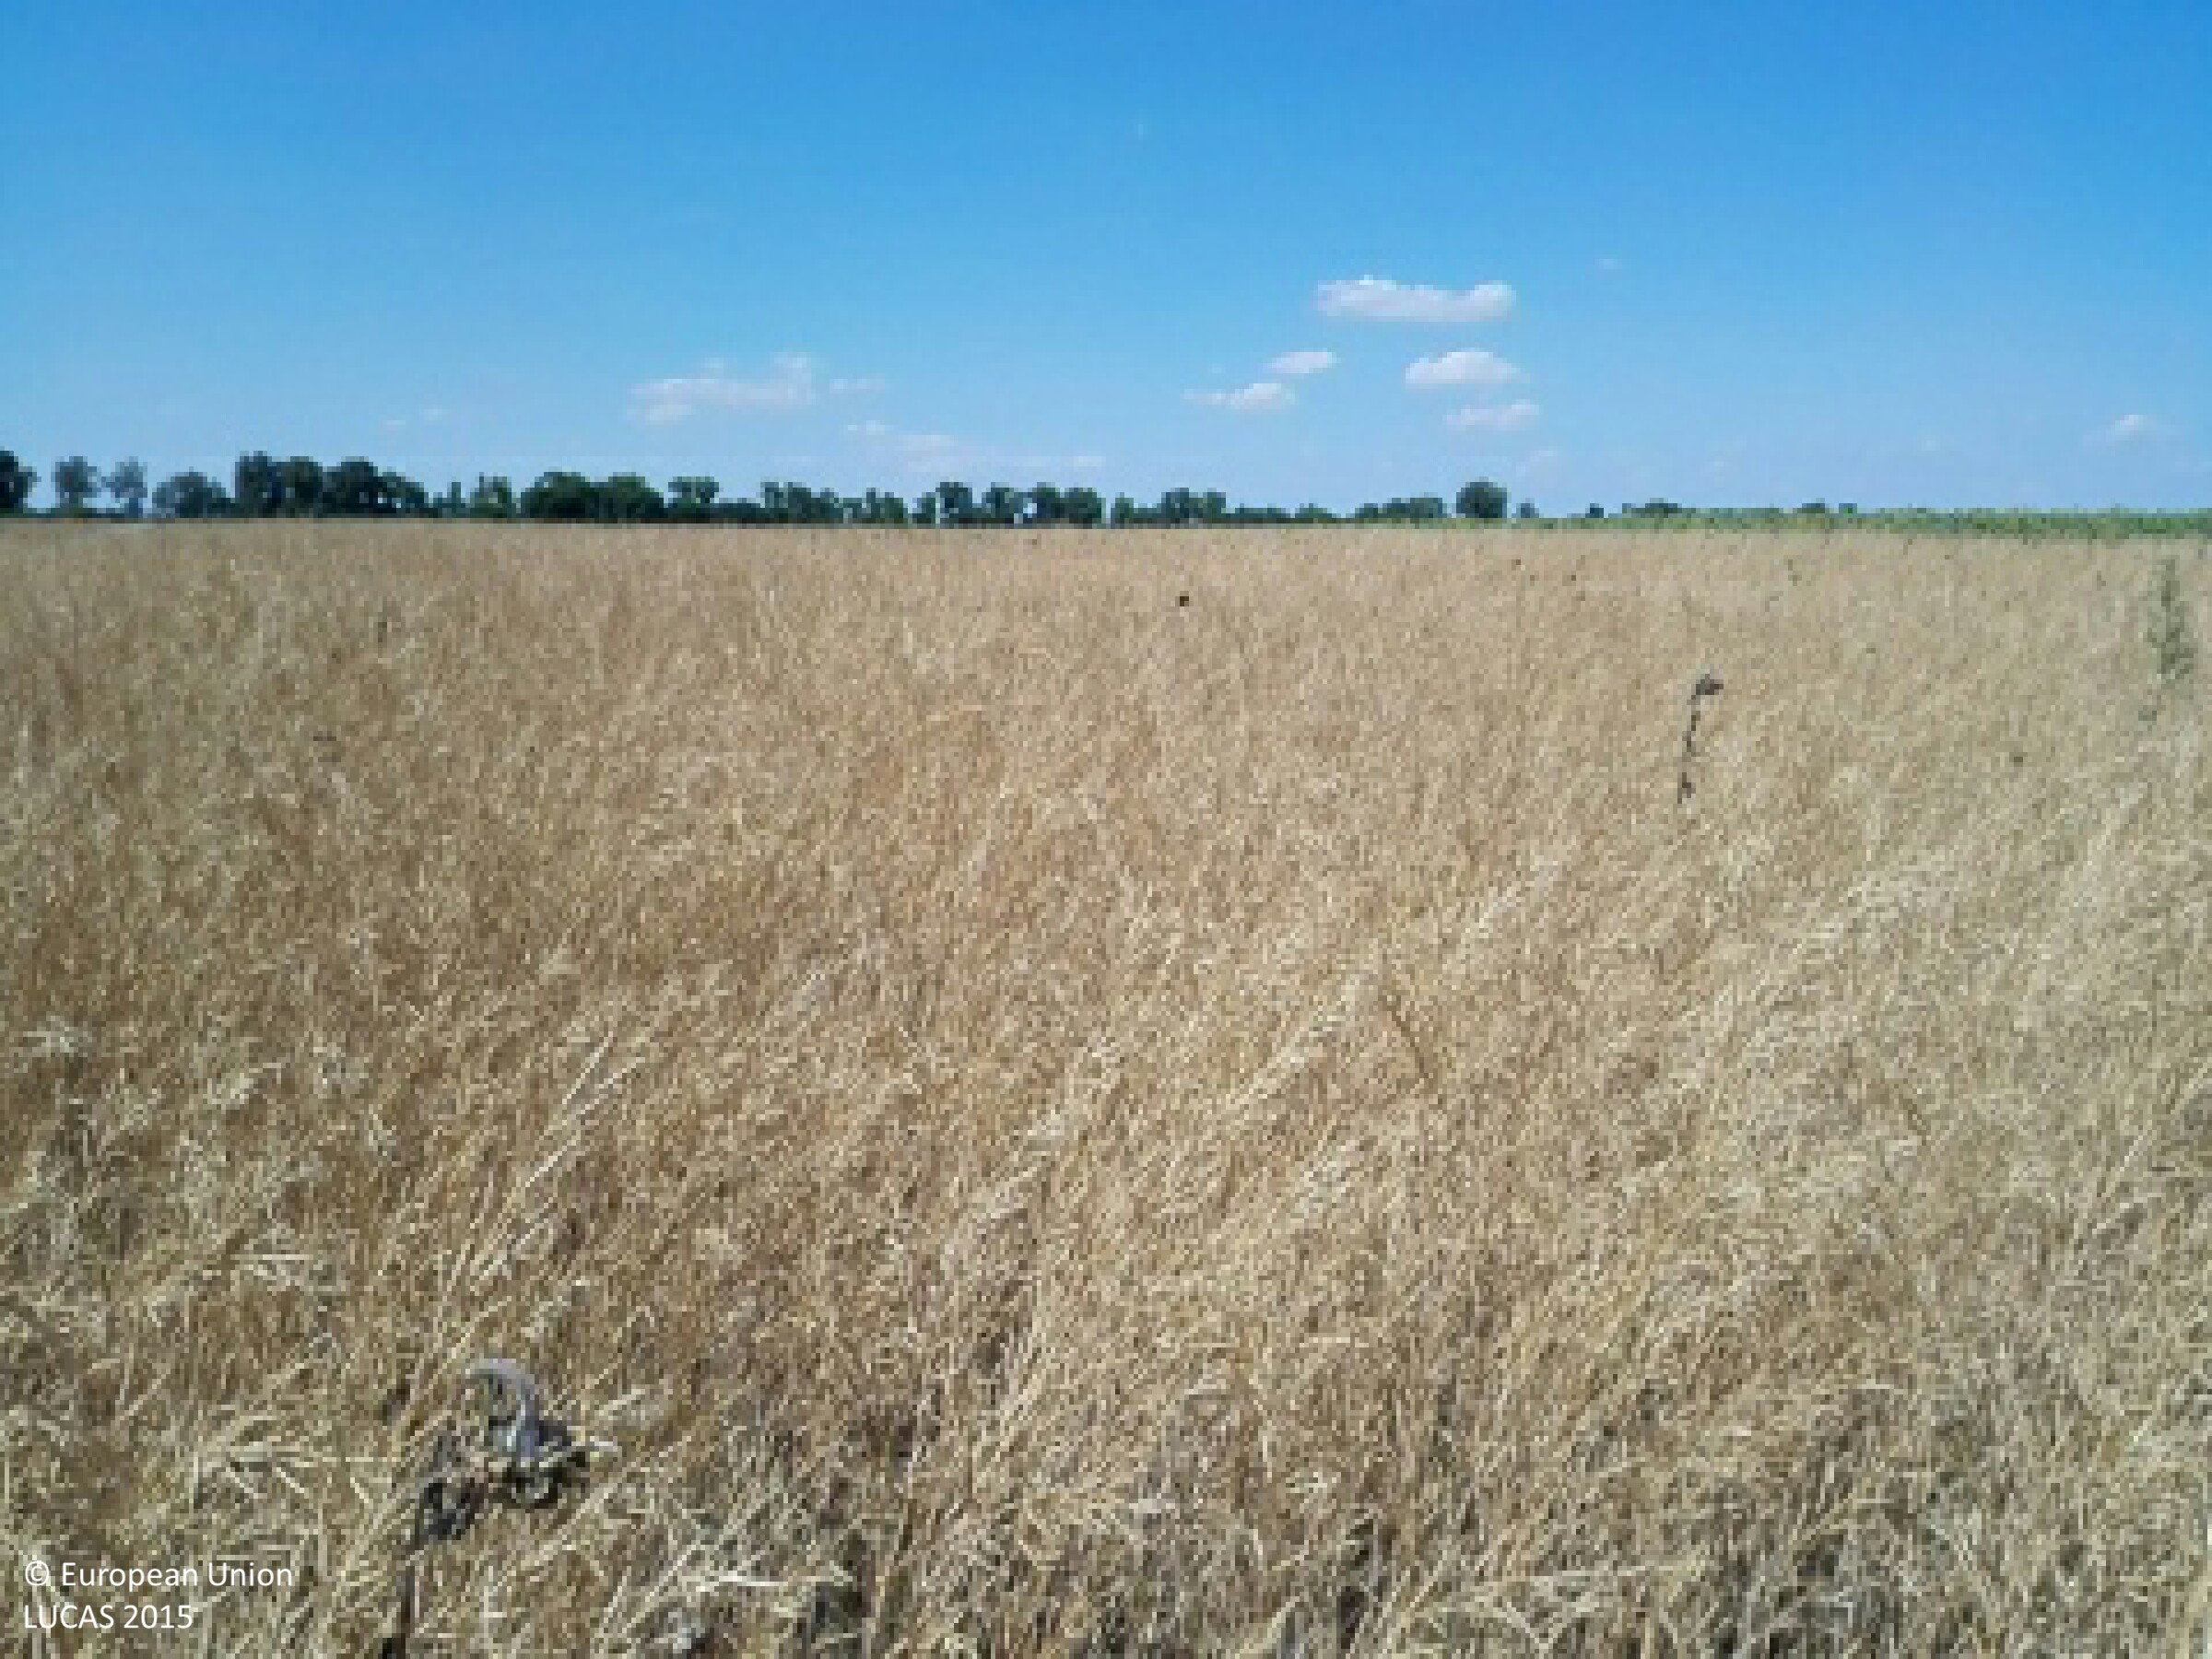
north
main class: Cropland
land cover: Rape and turnip rape
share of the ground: > 75 %
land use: Agriculture (excluding fallow land and kitchen gardens)
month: July
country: HU
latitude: 47.3848
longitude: 21.3125
